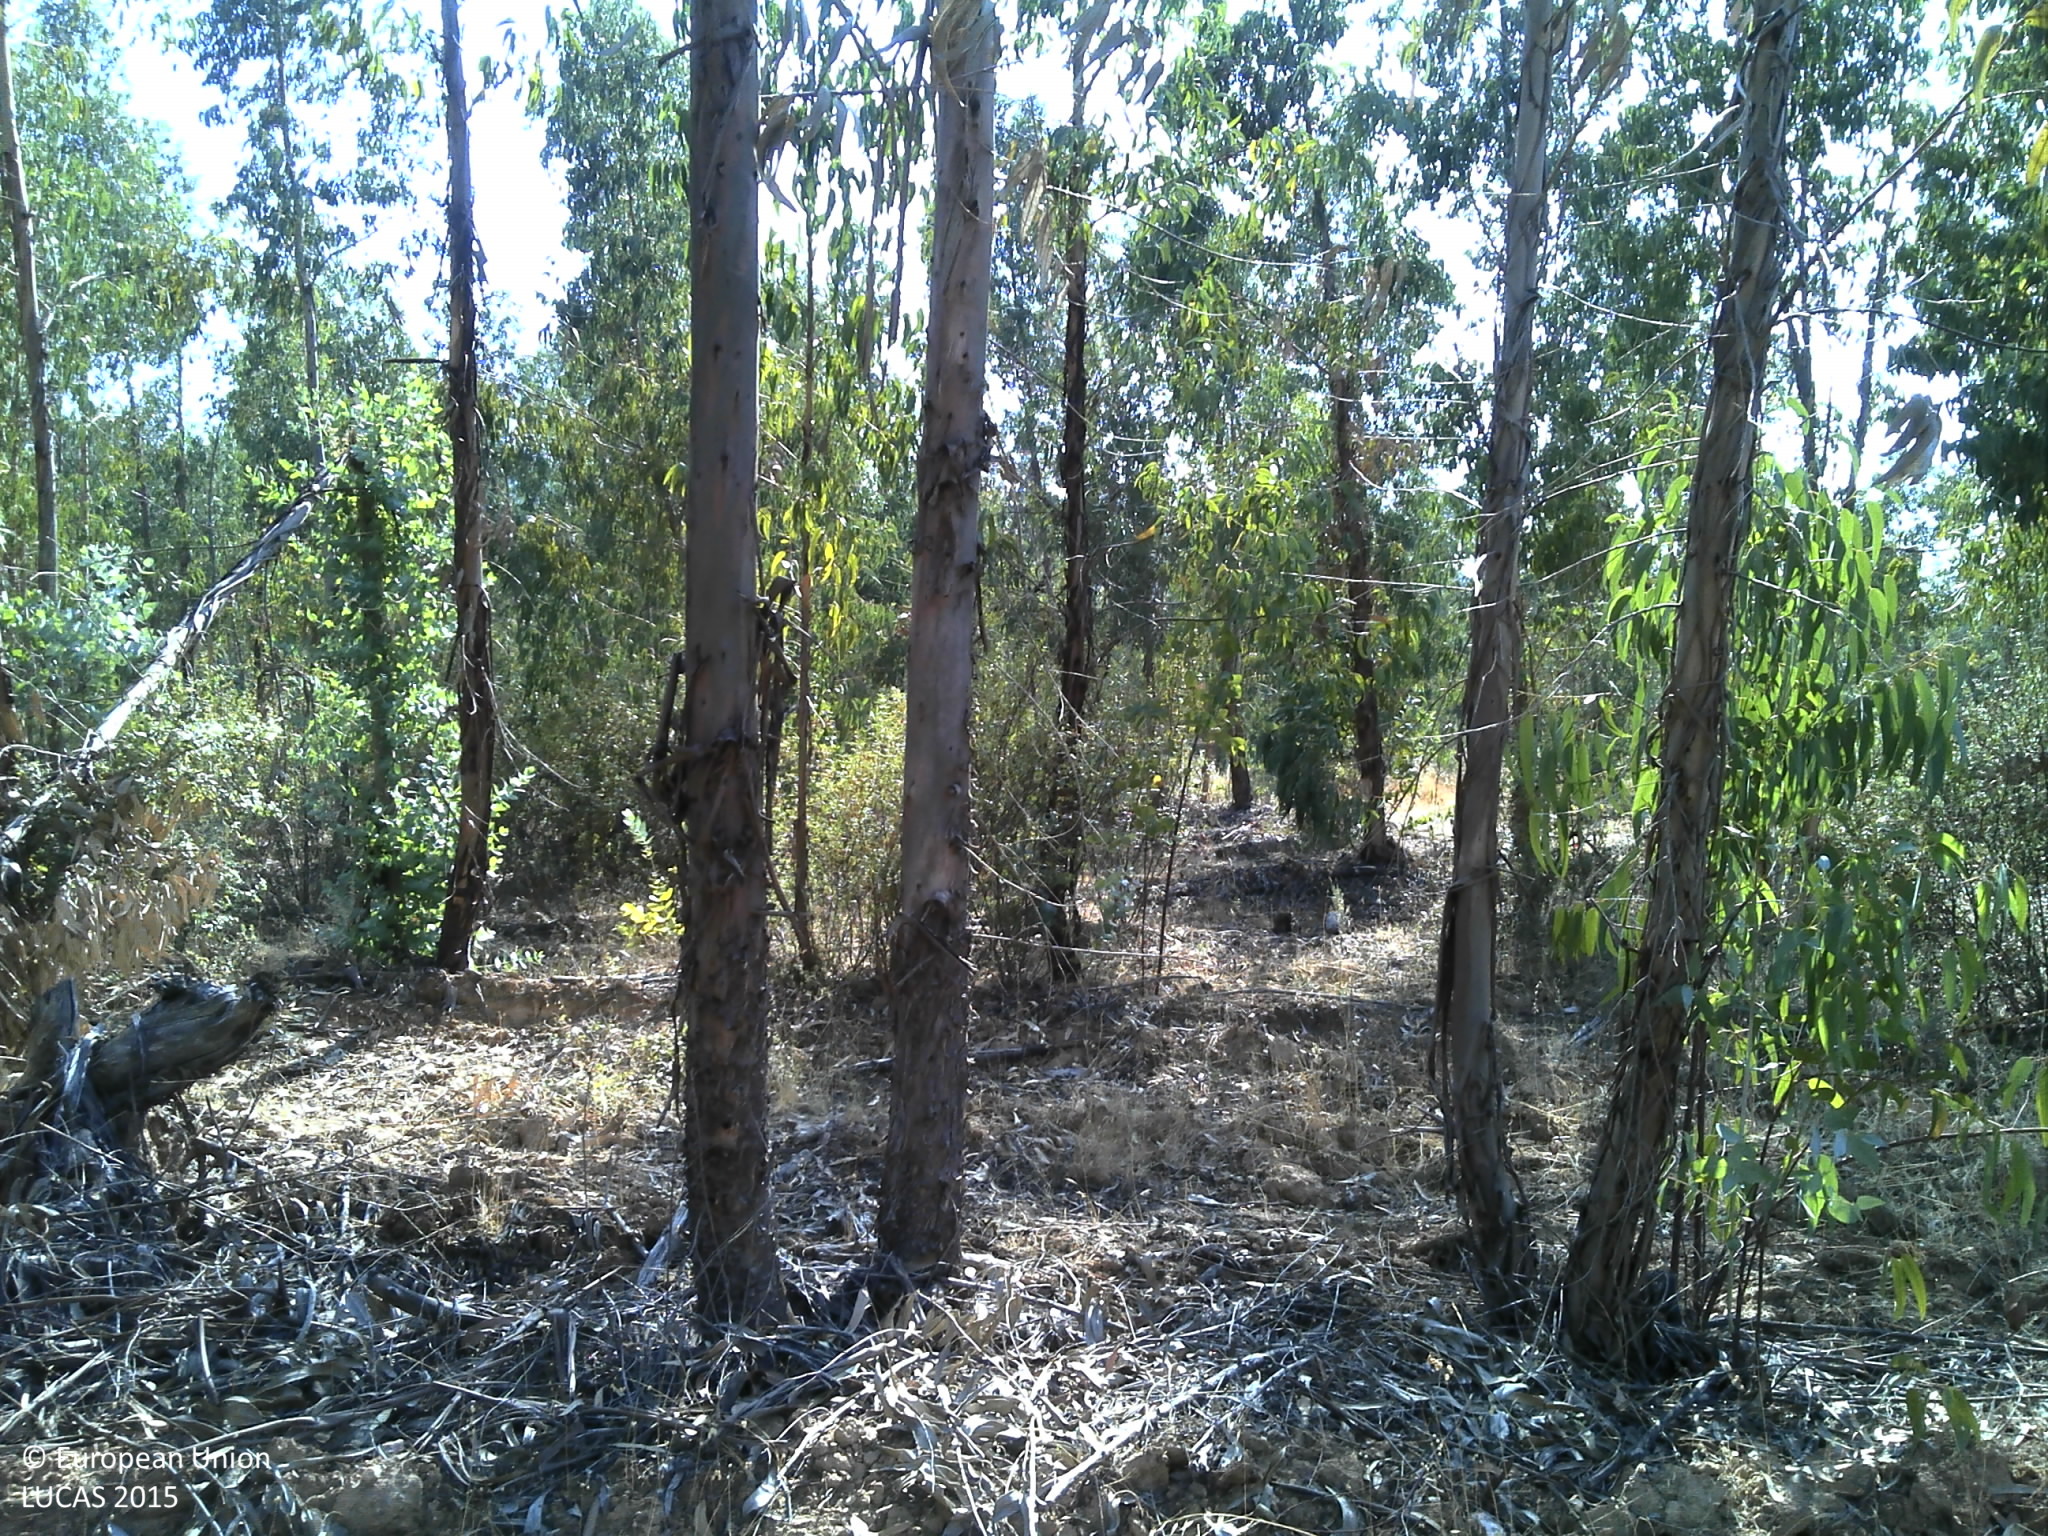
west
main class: Woodland
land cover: Broadleaved woodland
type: exotic forest
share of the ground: 50 - 75 %
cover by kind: broadleaved forest trees 75 %, shrubs 15 %, unconsolidated bare surface 10 %
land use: Forestry
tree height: > 5 m
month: July
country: PT
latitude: 38.7346
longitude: -7.5074
